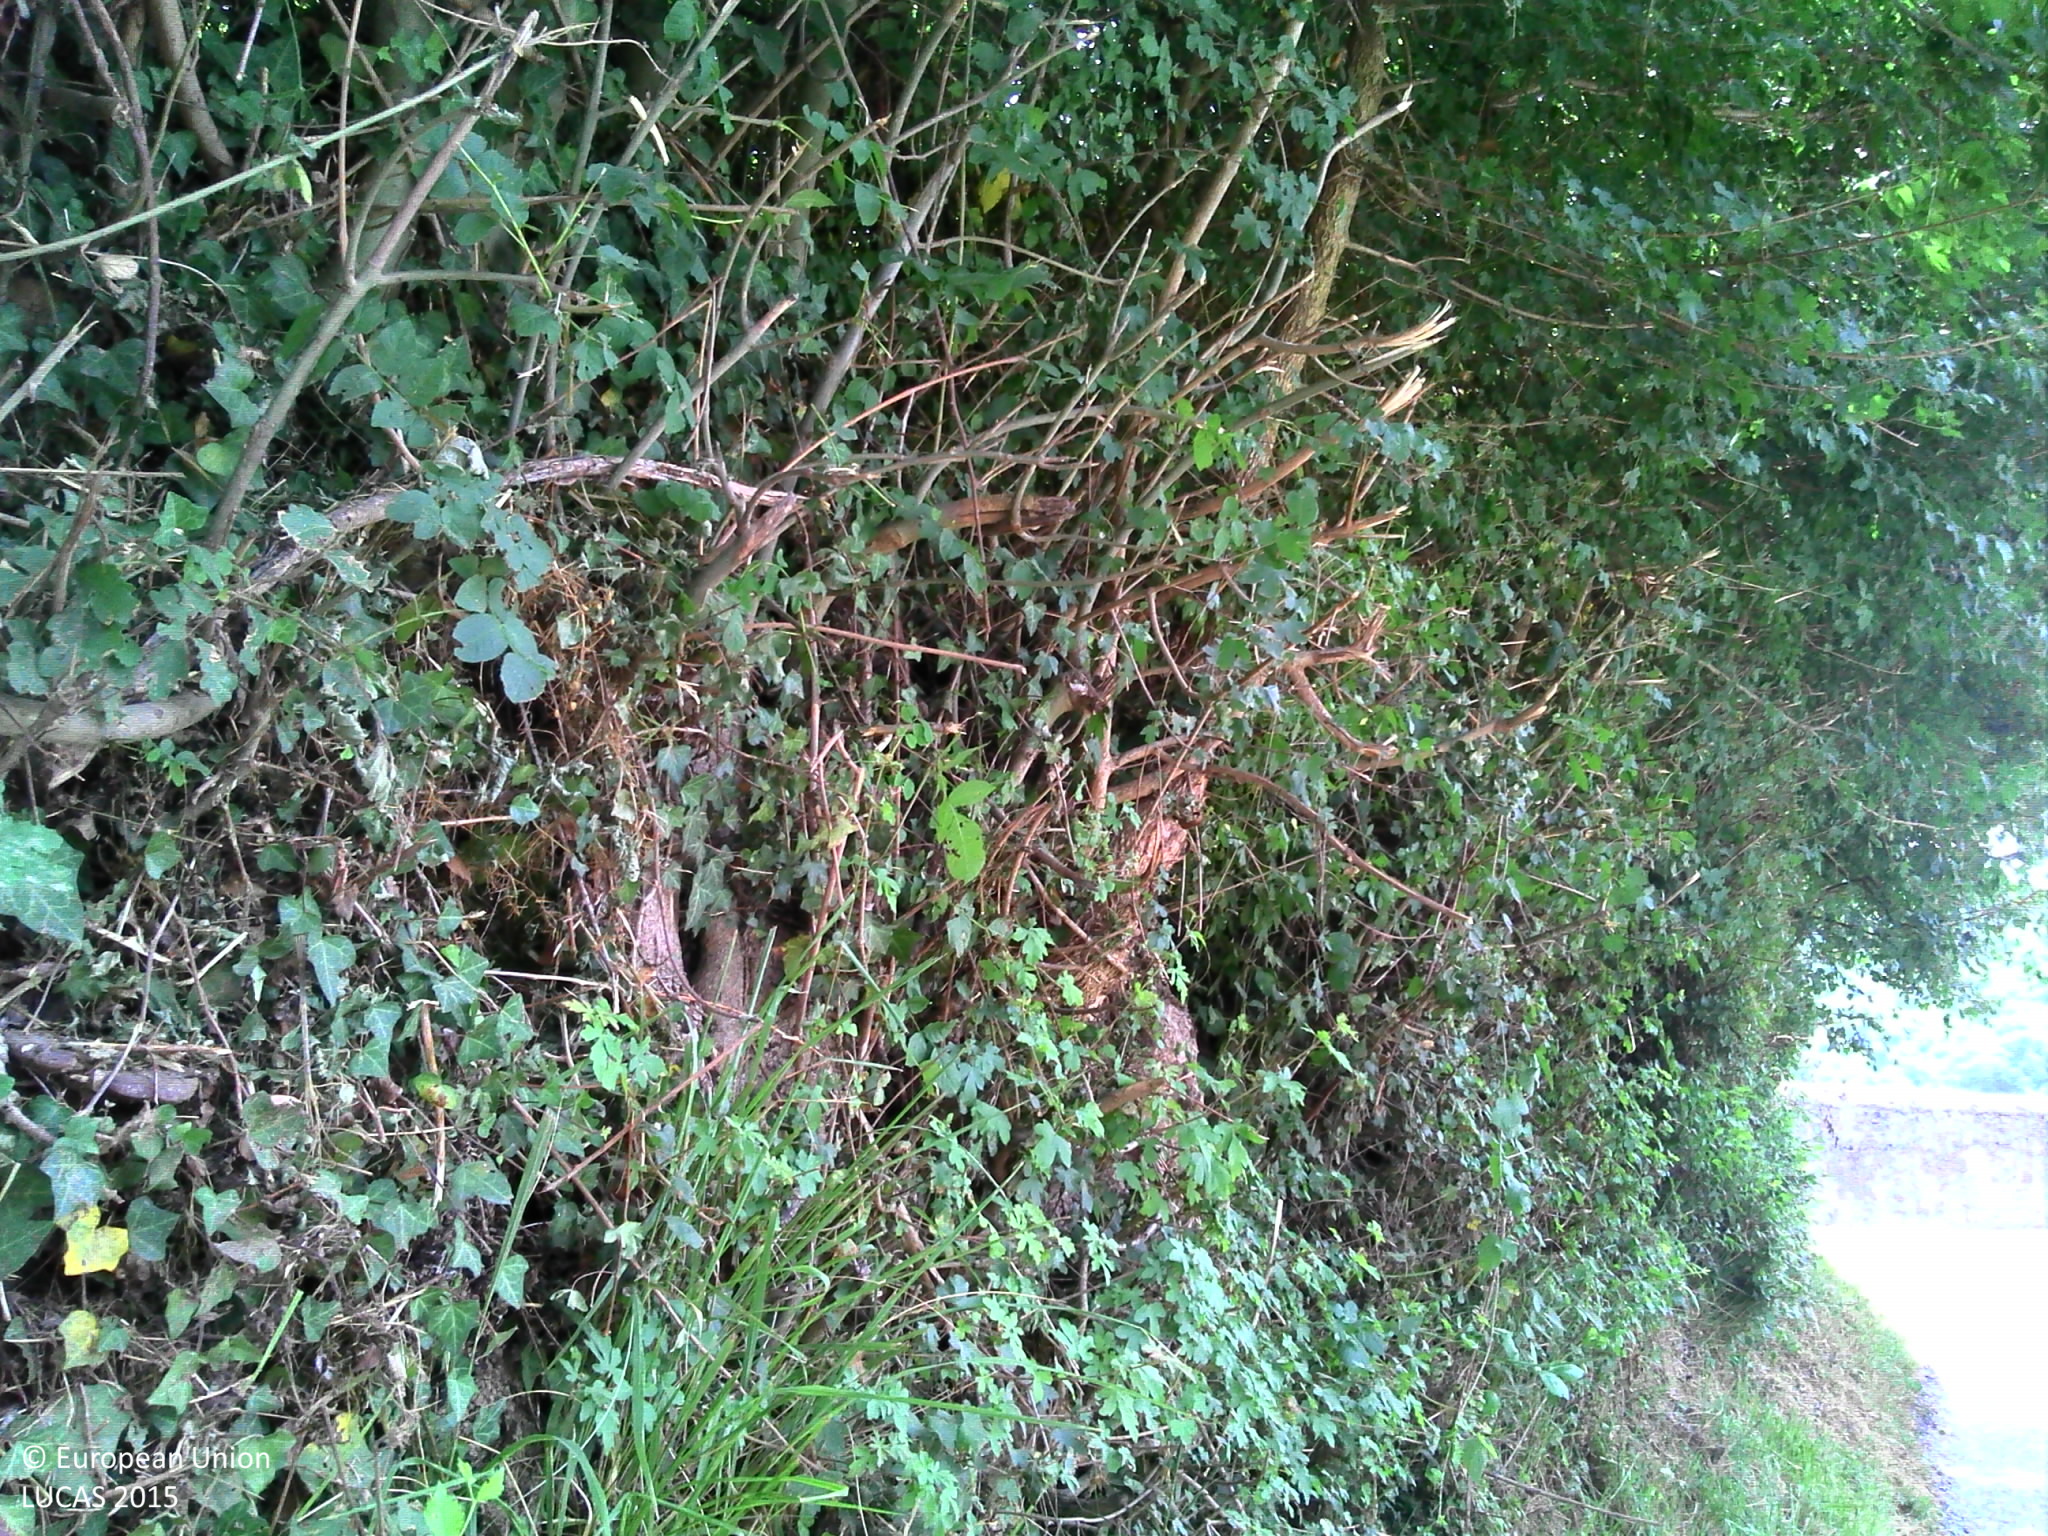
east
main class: Shrubland
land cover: Shrubland with sparse tree cover
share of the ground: > 75 %
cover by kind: shrubs 80 %, herbaceous plants 15 %, broadleaved forest trees 5 %
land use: Semi-natural and natural areas not in use
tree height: < 5 m
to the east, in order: Shrubland with sparse tree cover; Paved roads, cycling and walking lanes; Grass margins; Single bushes/trees; Grassland with sparse tree/shrub cover; Shrubland with sparse tree cover; Ditches and canals; Fences; Grassland without tree/shrub cover; Fences; Grassland without tree/shrub cover; Fences; Lines of trees; Fences; Ditches and canals; Grassland without tree/shrub cover
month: July
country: FR
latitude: 43.0502
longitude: 0.7827
